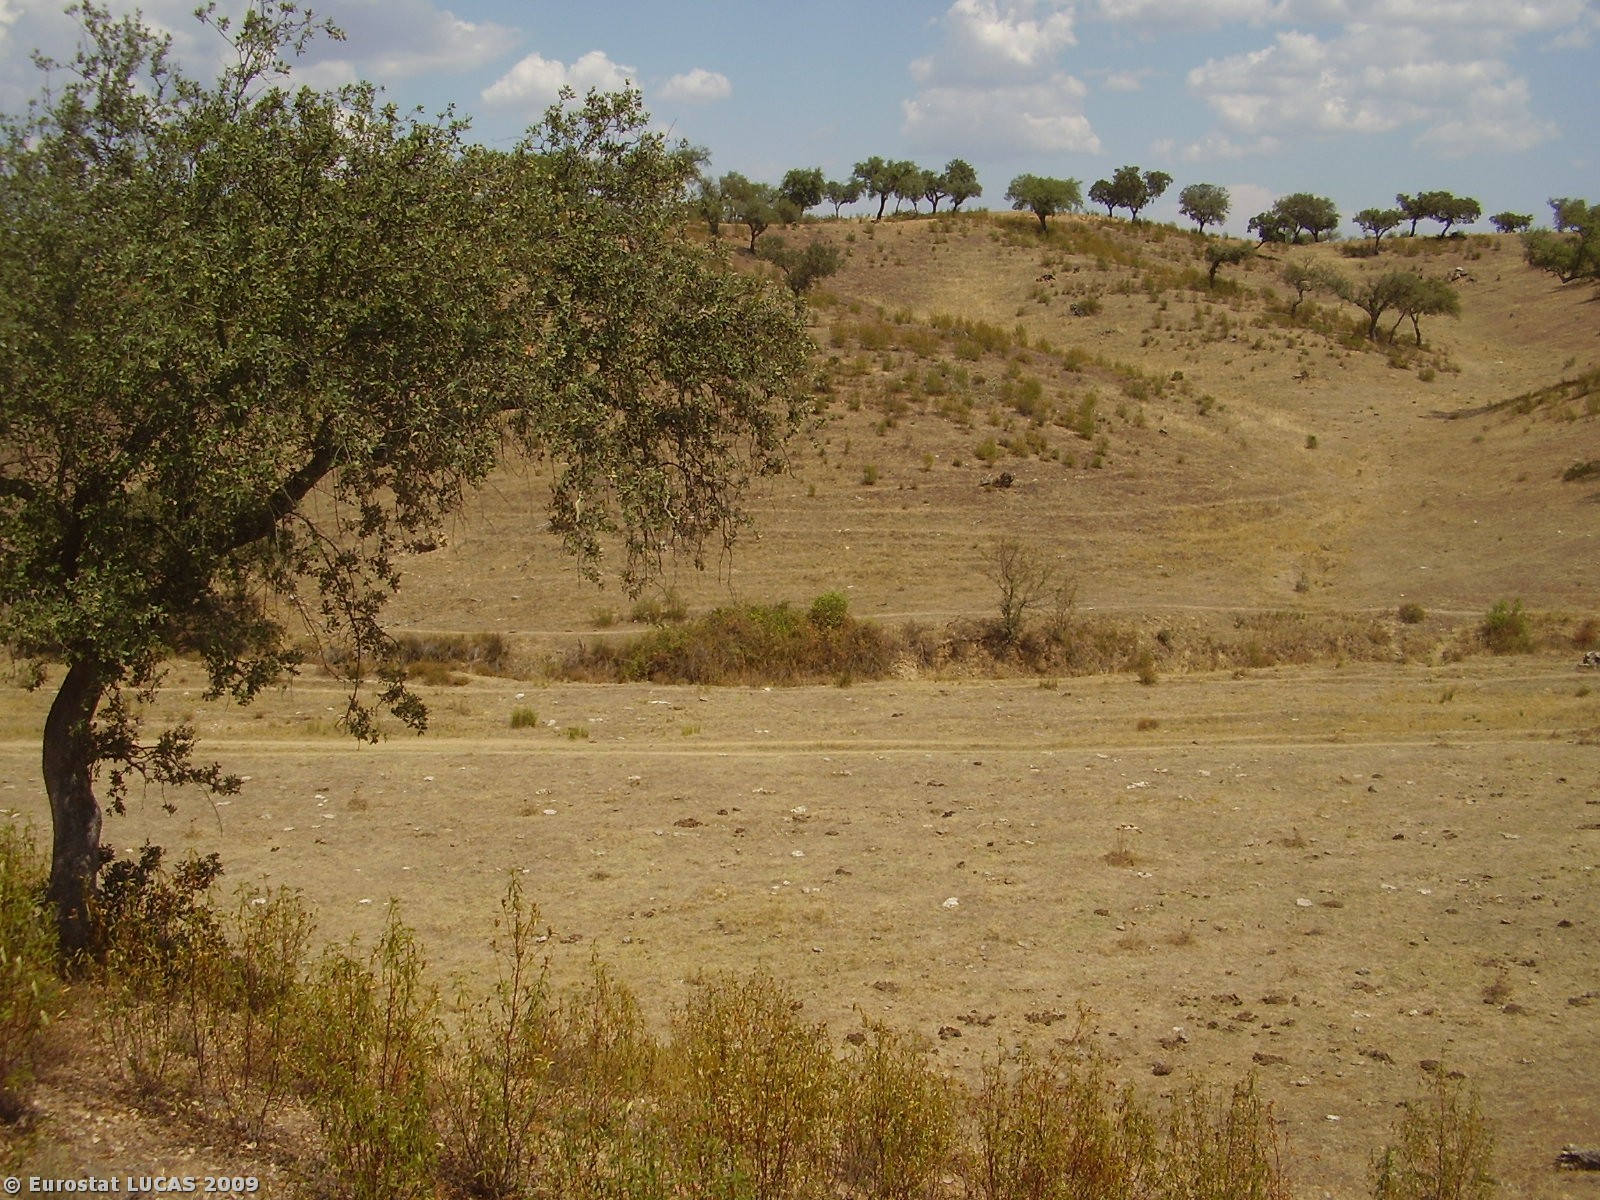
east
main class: Woodland
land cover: Broadleaved woodland
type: broadleaved evergreen forest
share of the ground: 10 - 25 %
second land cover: Bare land
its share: > 75 %
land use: Forestry
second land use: Fallow land
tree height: > 5 m
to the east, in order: Broadleaved woodland; Bare land; Broadleaved woodland; Bare land; Rivers and streams; Grassland without tree/shrub cover; Tracks; Broadleaved woodland; Grassland without tree/shrub cover
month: August
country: PT
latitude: 38.2556
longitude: -7.8948
